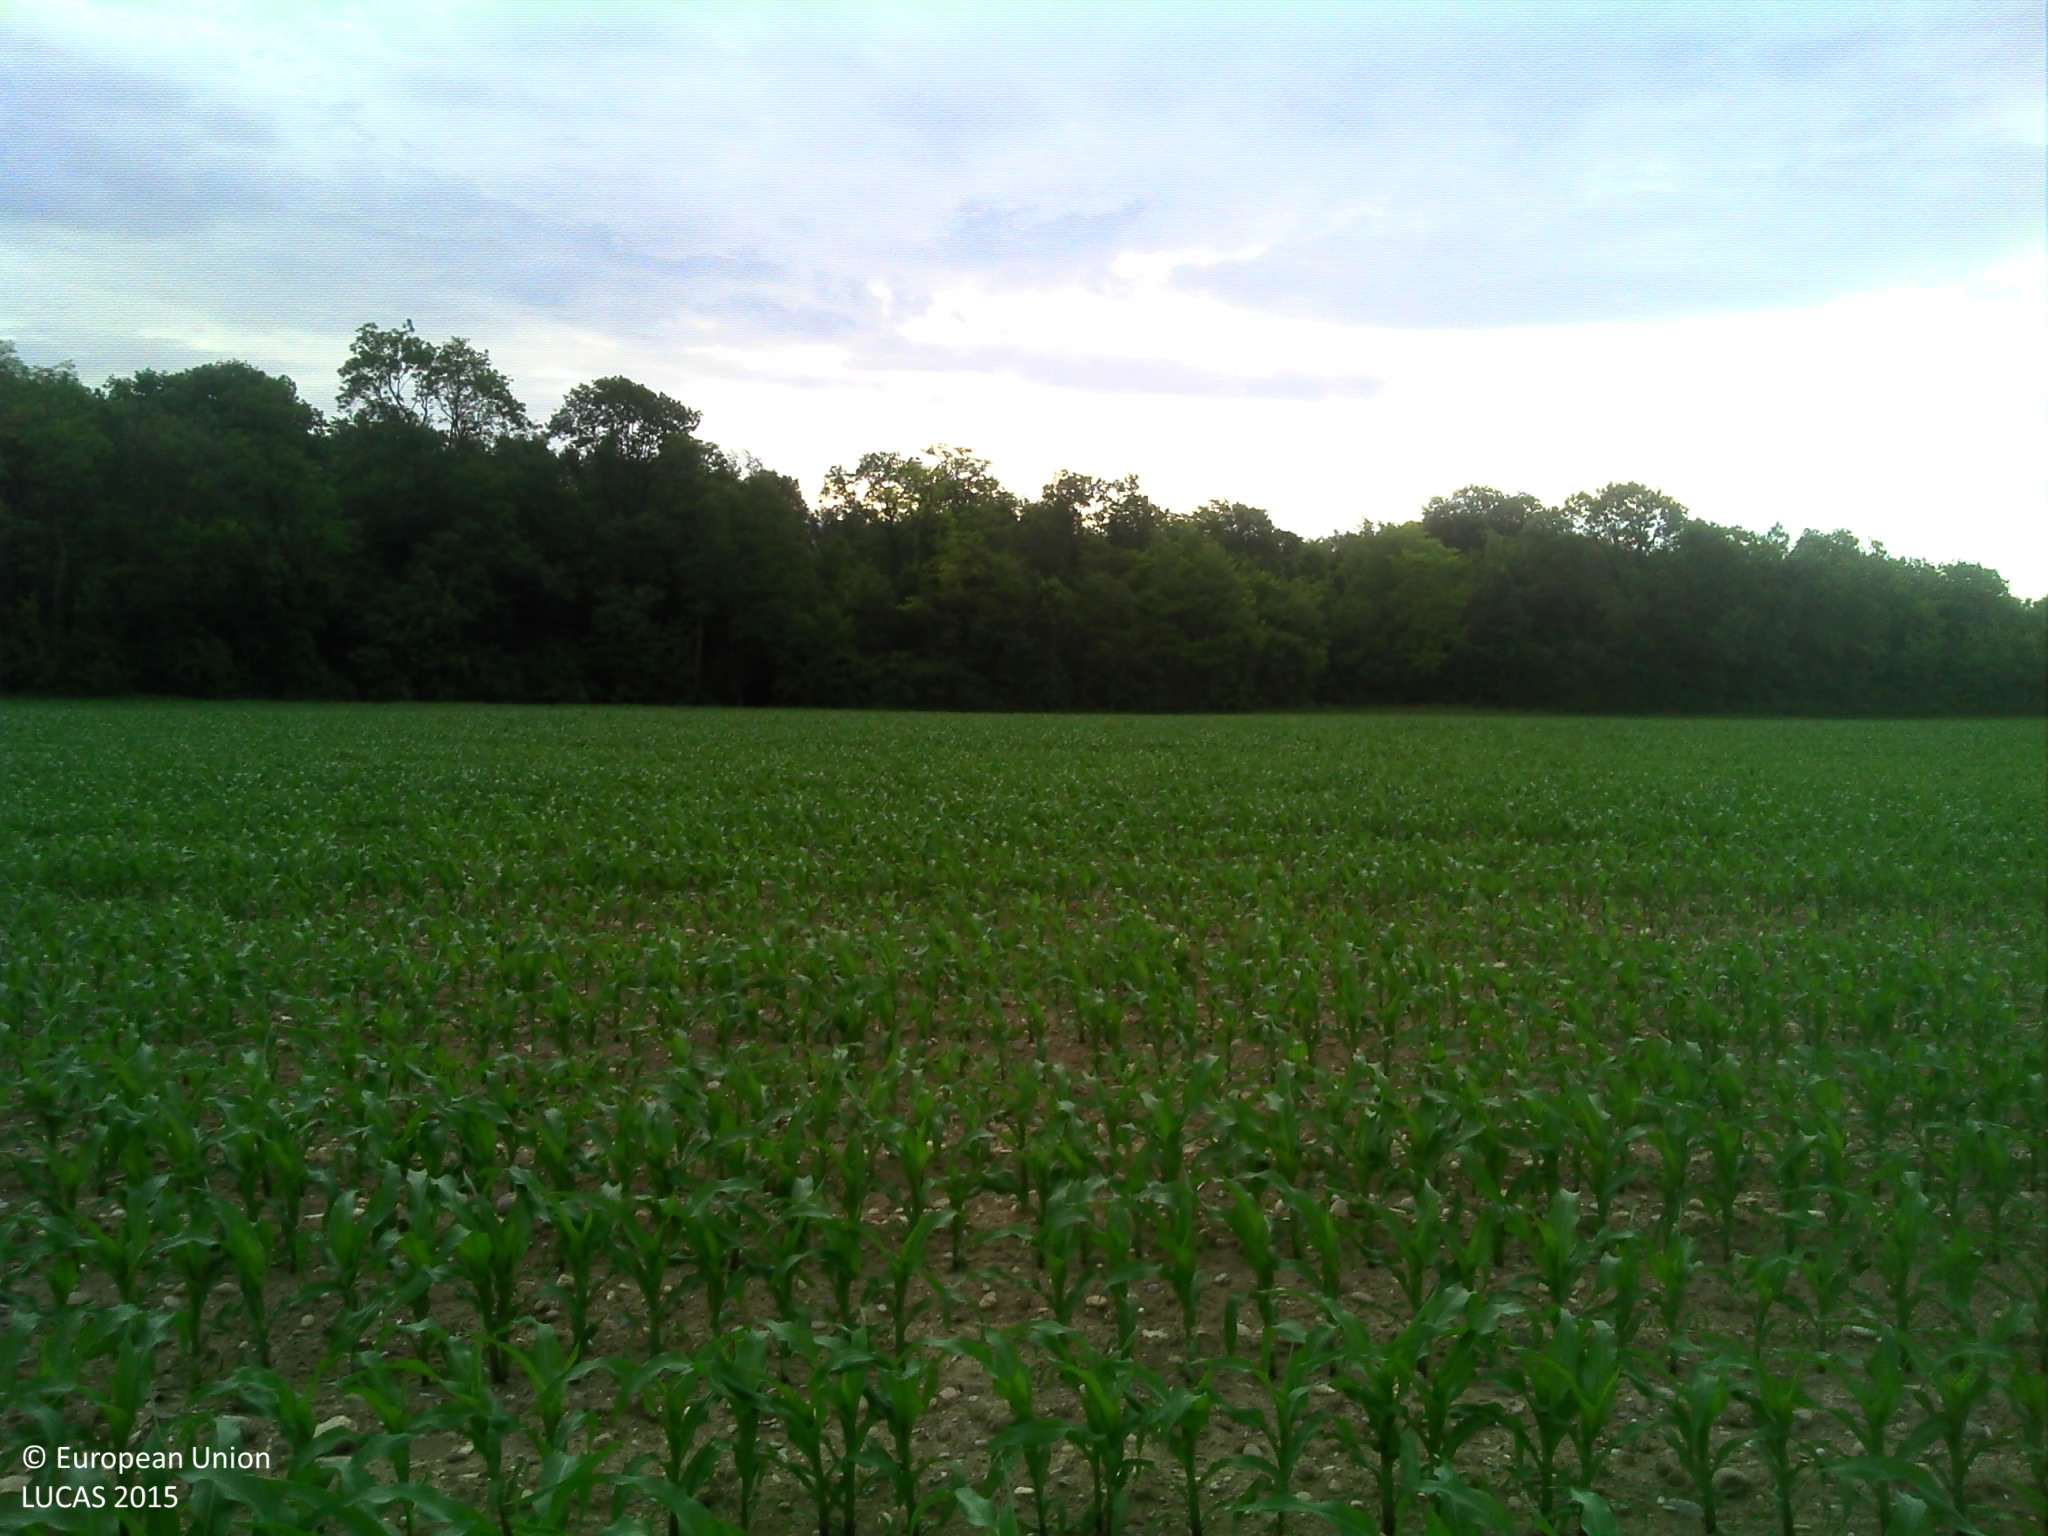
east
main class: Cropland
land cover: Maize
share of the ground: 10 - 25 %
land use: Agriculture (excluding fallow land and kitchen gardens)
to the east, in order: Maize; Grass margins; Tracks; Grass margins; Broadleaved woodland; Tracks; Broadleaved woodland
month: June
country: FR
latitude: 47.9989
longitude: 7.5754
